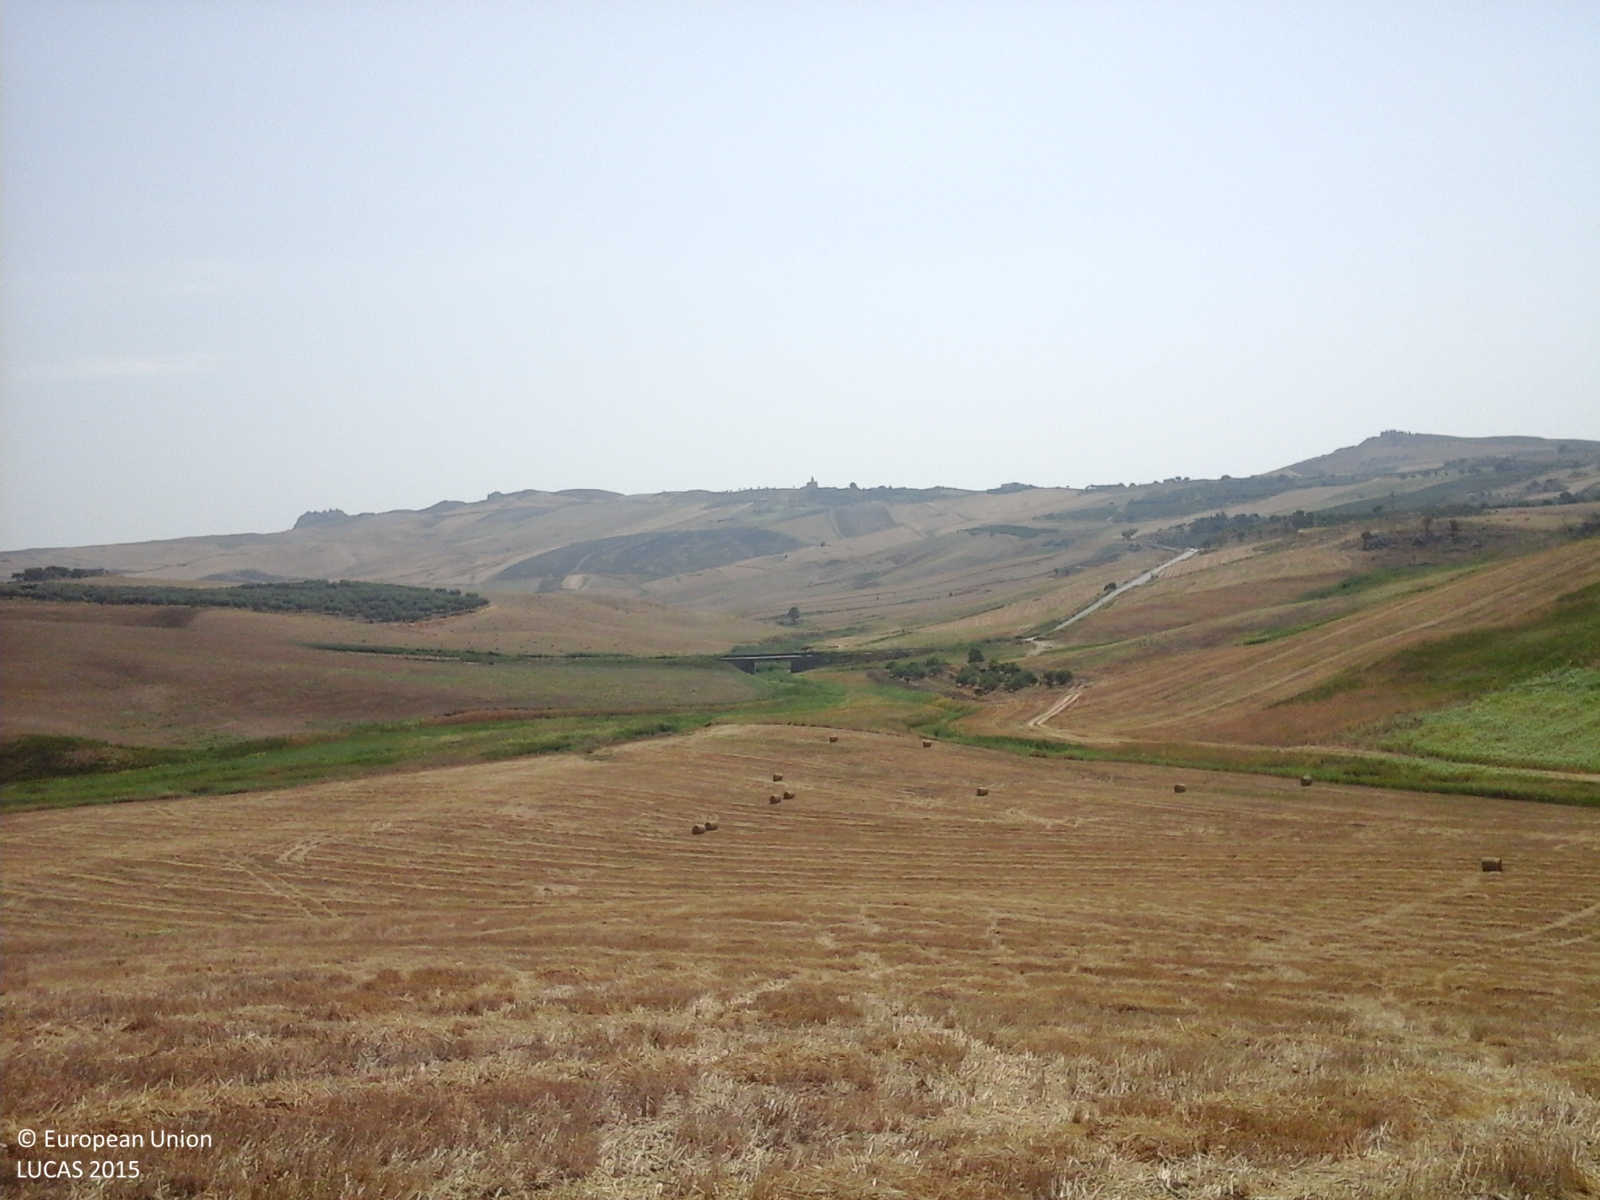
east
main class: Cropland
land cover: Durum wheat
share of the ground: > 75 %
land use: Agriculture (excluding fallow land and kitchen gardens)
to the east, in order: Durum wheat
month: July
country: IT
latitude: 37.3916
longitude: 13.9795
